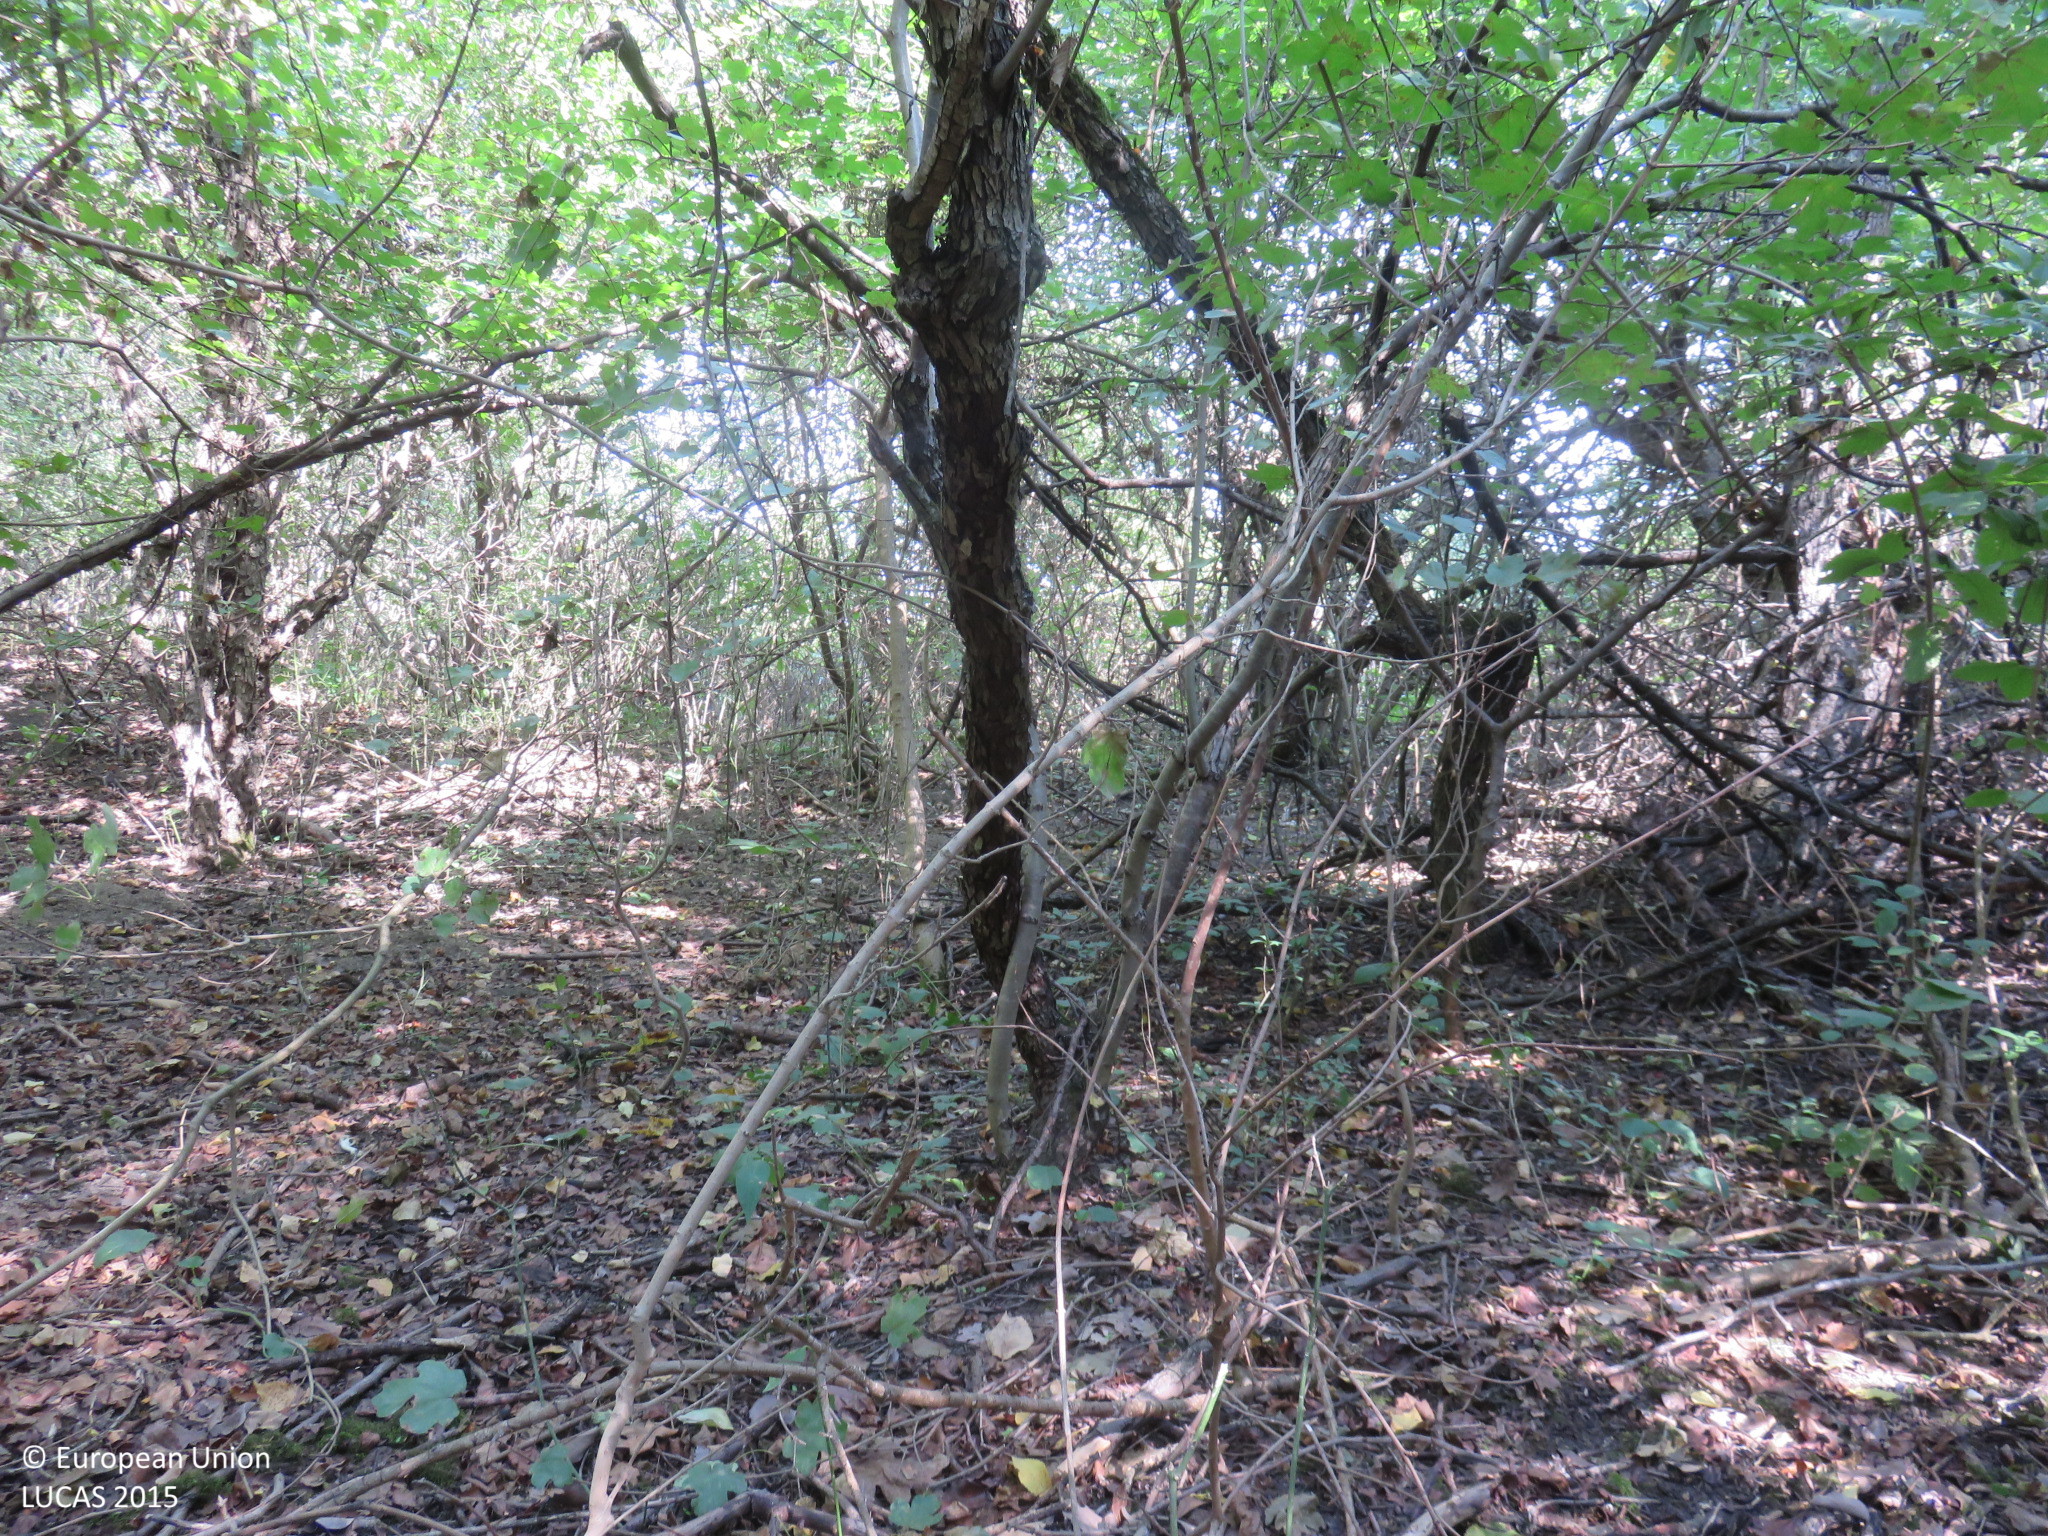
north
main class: Woodland
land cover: Broadleaved woodland
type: mesophytic deciduous forest
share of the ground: > 75 %
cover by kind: broadleaved forest trees 95 %, shrubs 5 %
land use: Forestry
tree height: < 5 m
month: September
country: BG
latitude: 43.4952
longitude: 24.9722
